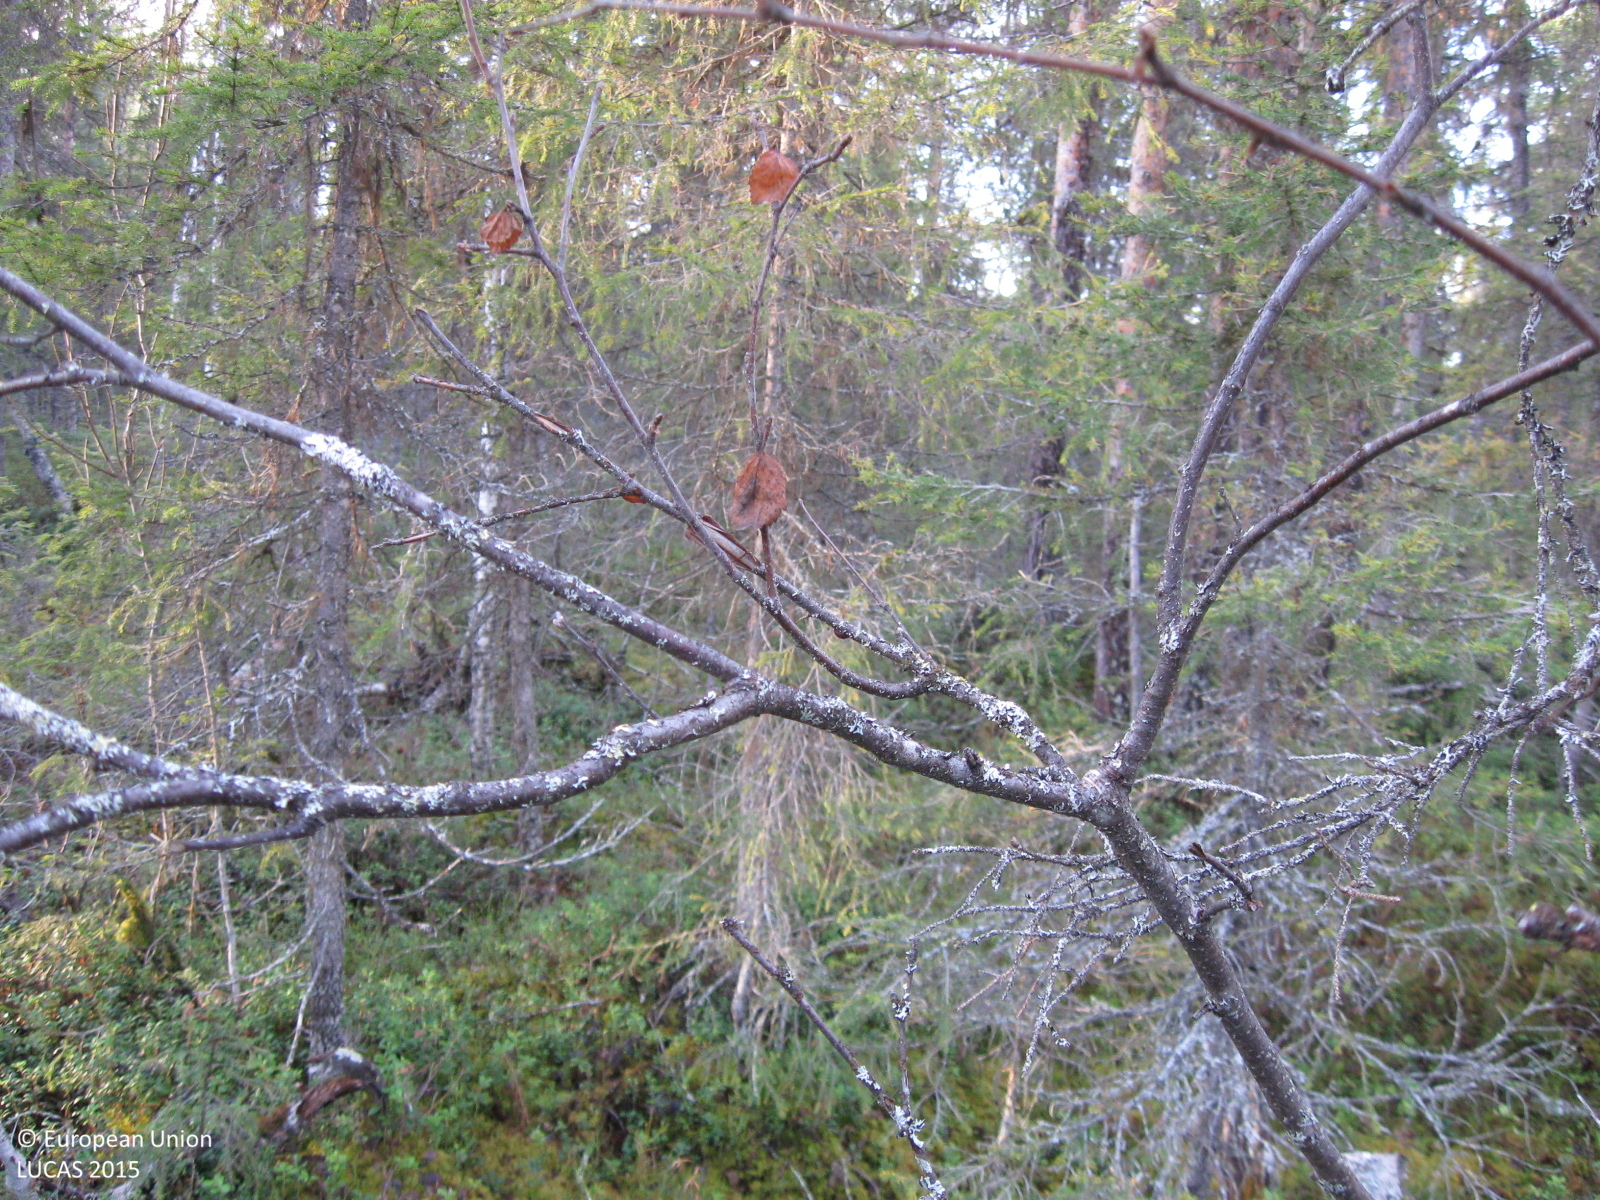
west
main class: Woodland
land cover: Other coniferous woodland
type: boreal forest
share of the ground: > 75 %
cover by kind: coniferous forest trees 65 %, broadleaved forest trees 20 %, shrubs 5 %, herbaceous plants 5 %, lichens and mosses 5 %
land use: Forestry
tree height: > 5 m
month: November
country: SE
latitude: 66.1930
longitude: 20.6838
